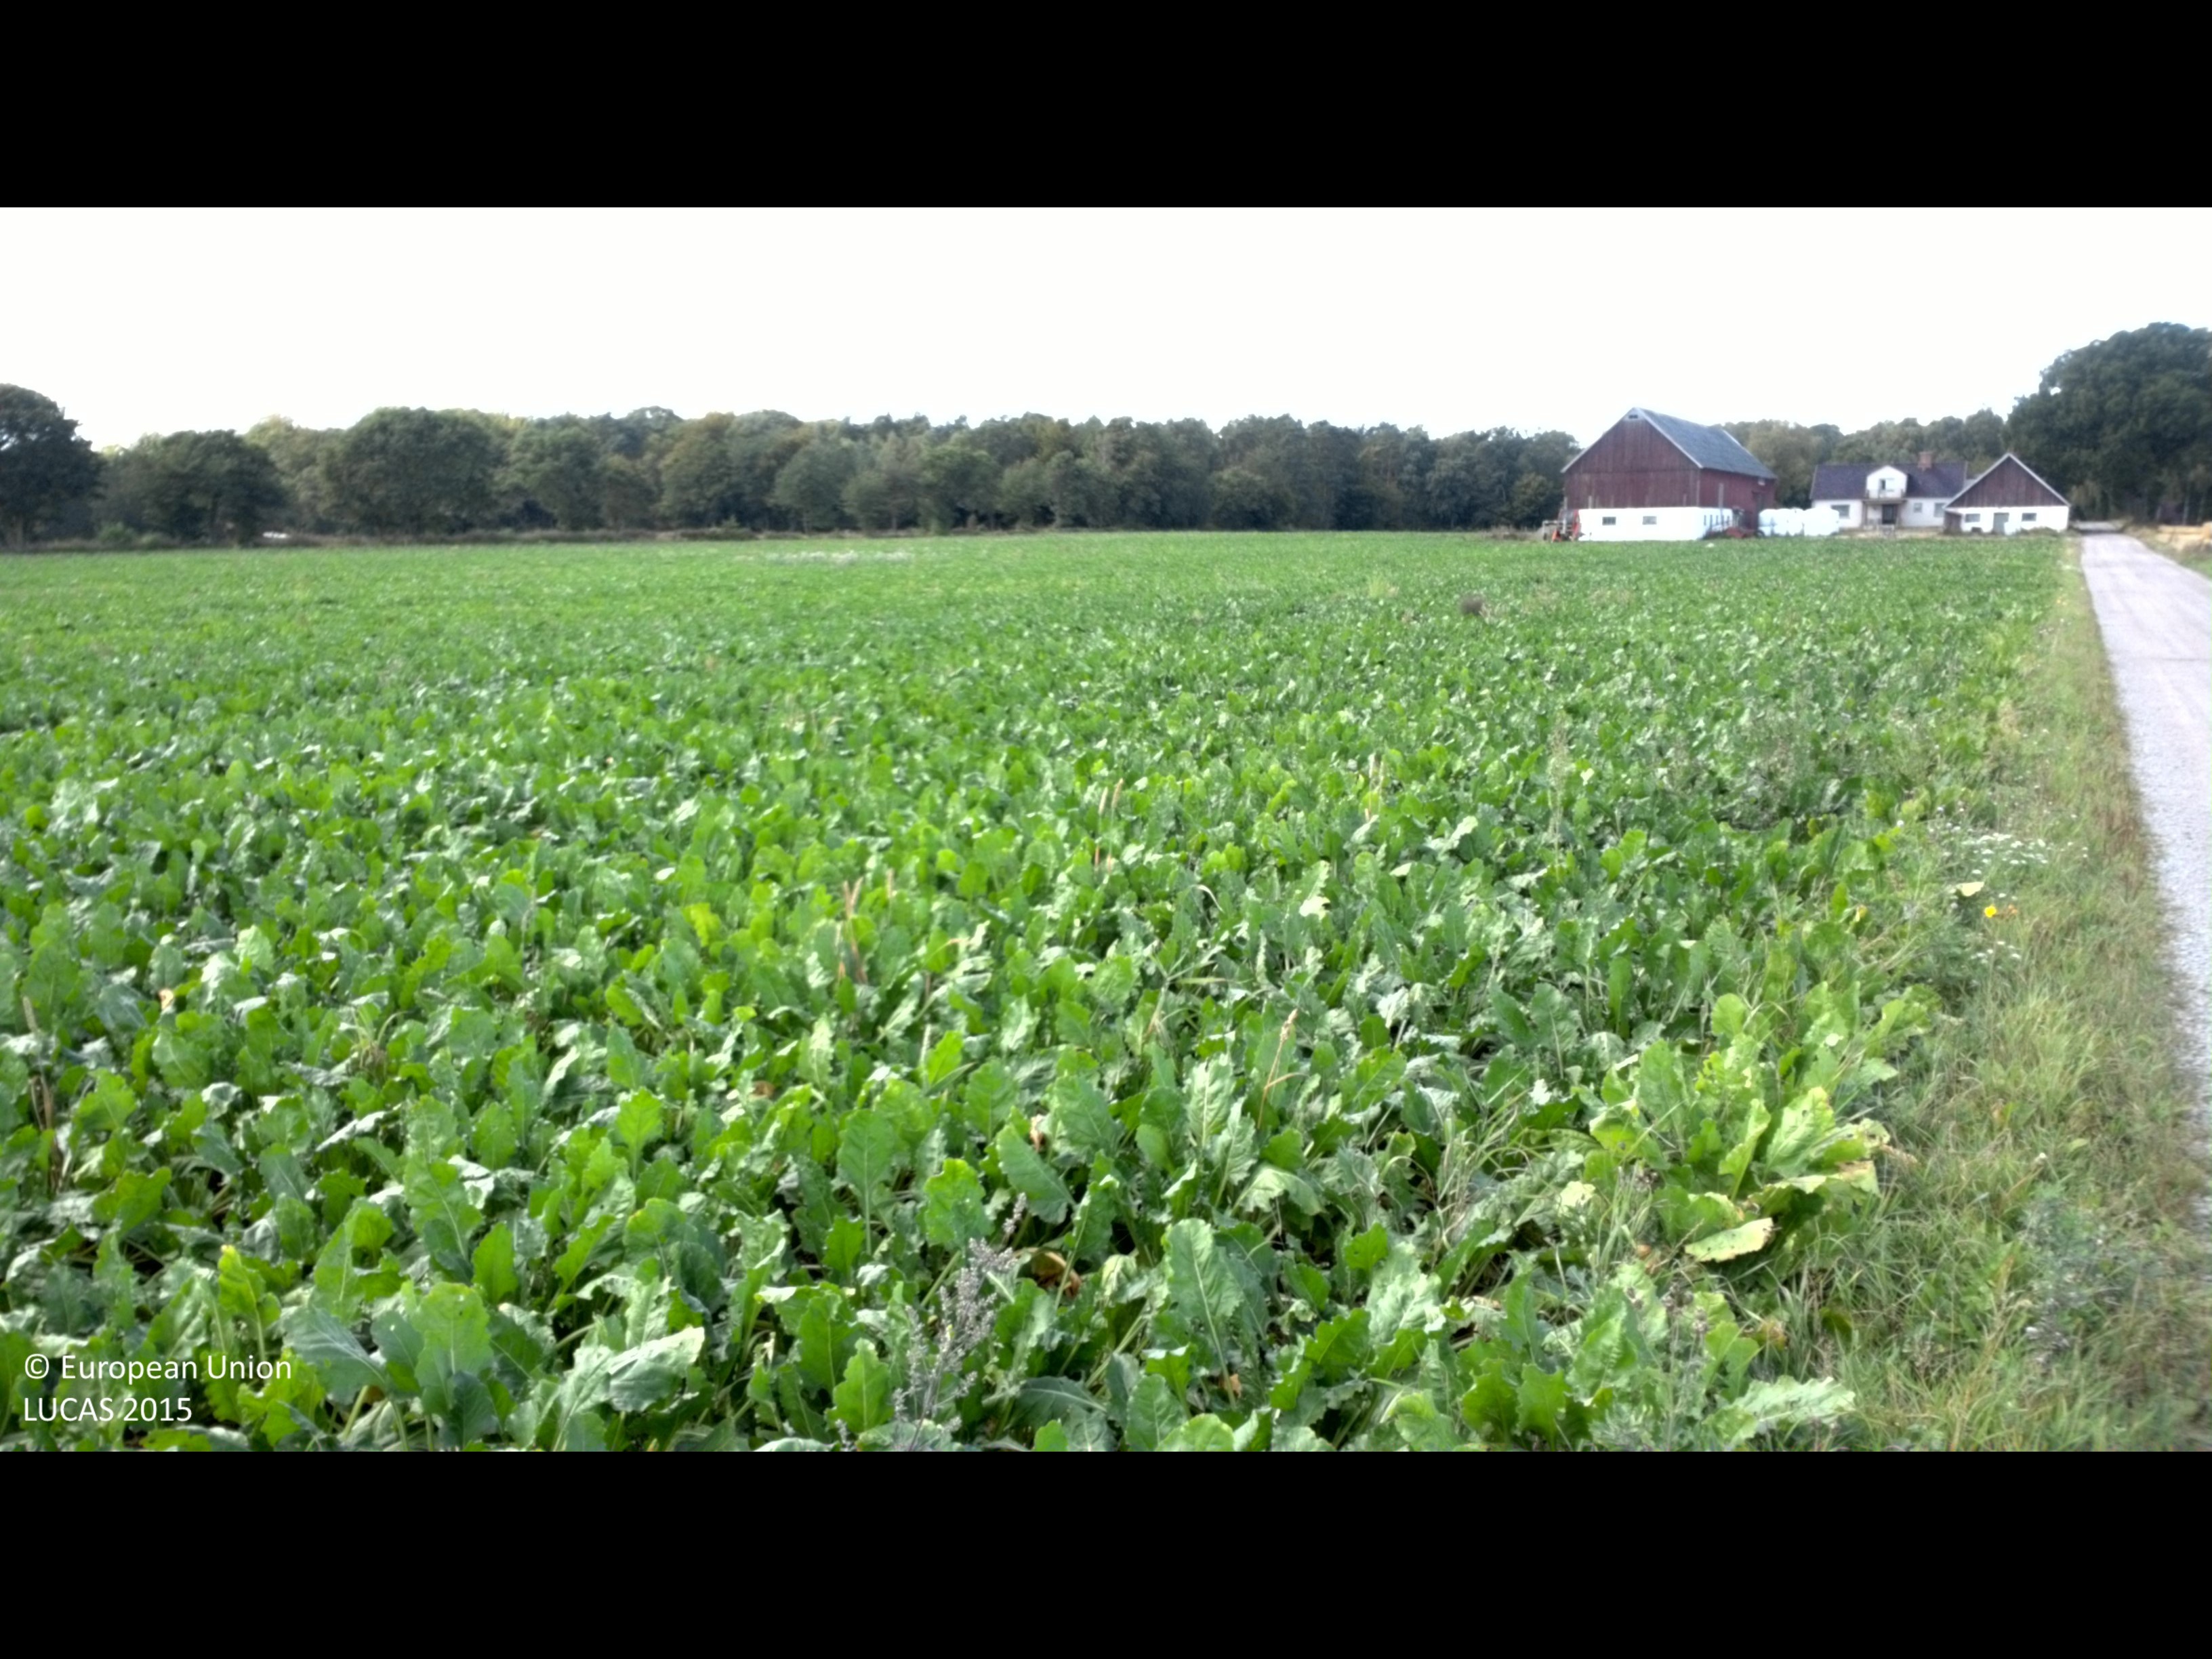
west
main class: Cropland
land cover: Sugar beet
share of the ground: > 75 %
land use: Agriculture (excluding fallow land and kitchen gardens)
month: September
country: SE
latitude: 56.1026
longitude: 14.6769
